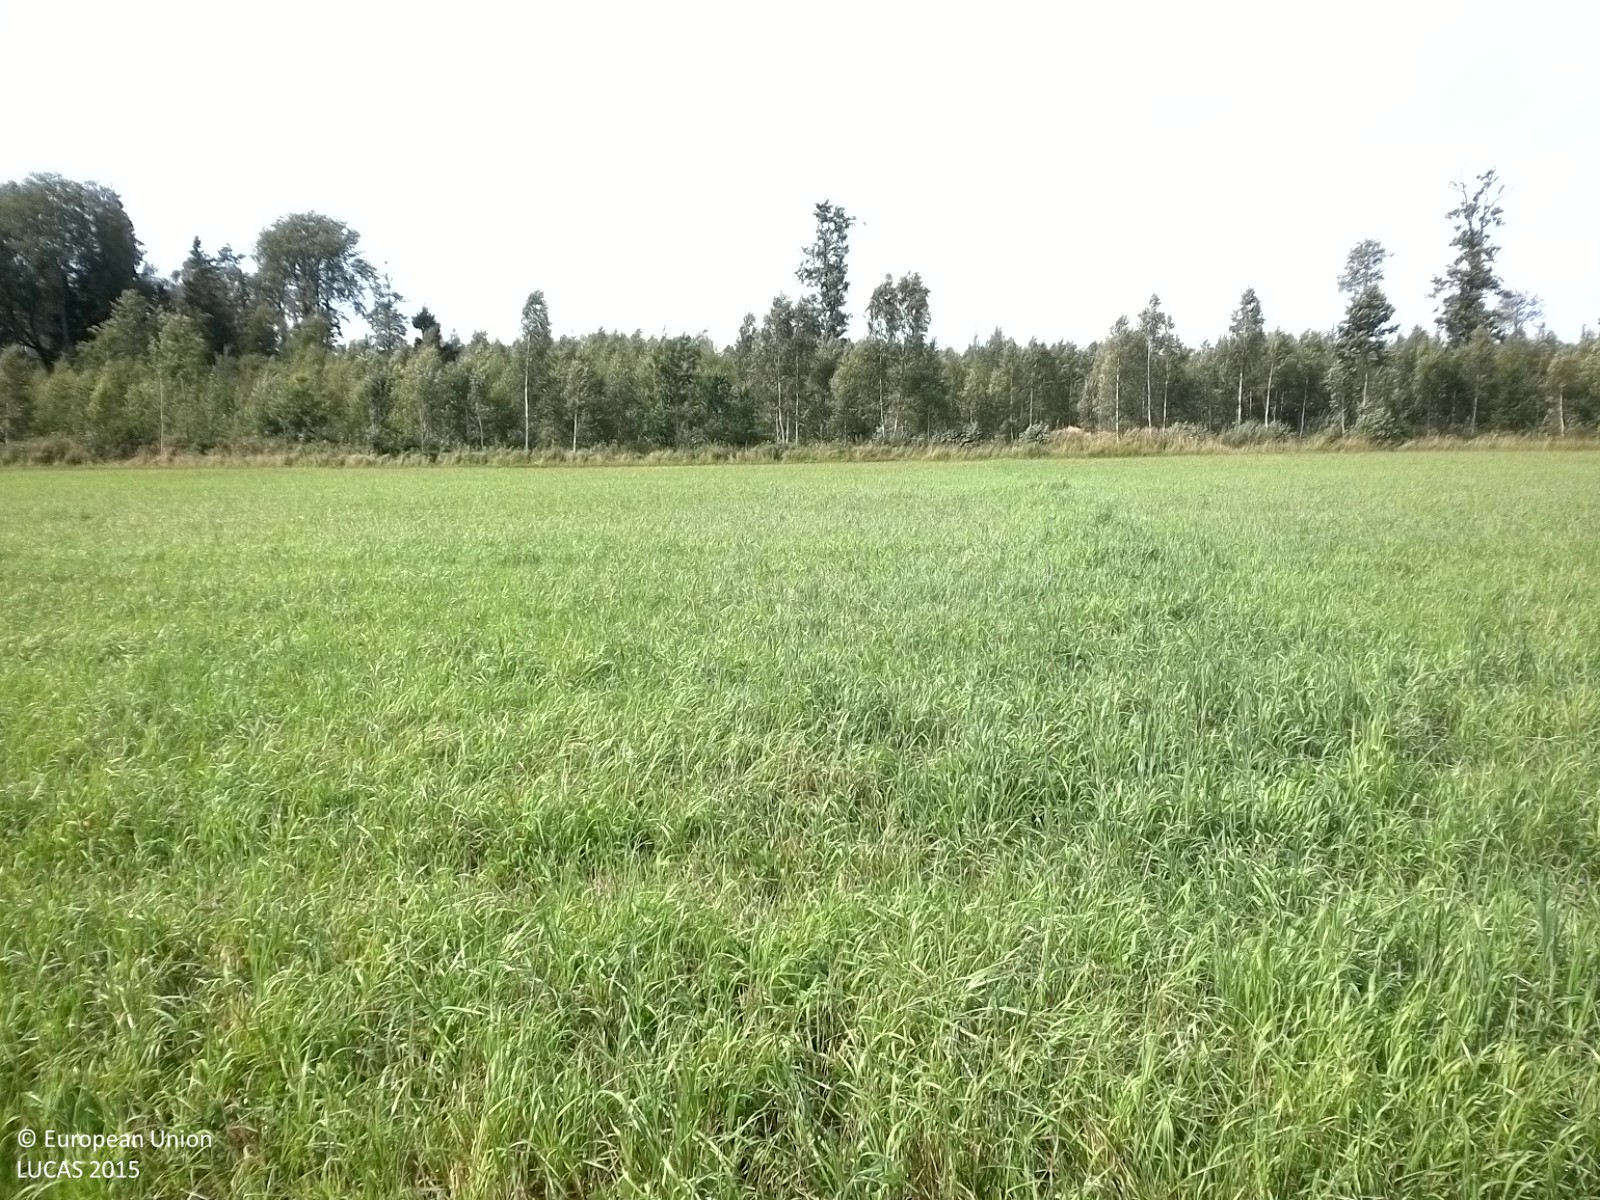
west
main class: Cropland
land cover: Temporary grasslands
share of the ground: > 75 %
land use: Agriculture (excluding fallow land and kitchen gardens)
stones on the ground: < 10 %
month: August
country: SE
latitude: 59.1254
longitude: 14.7965
